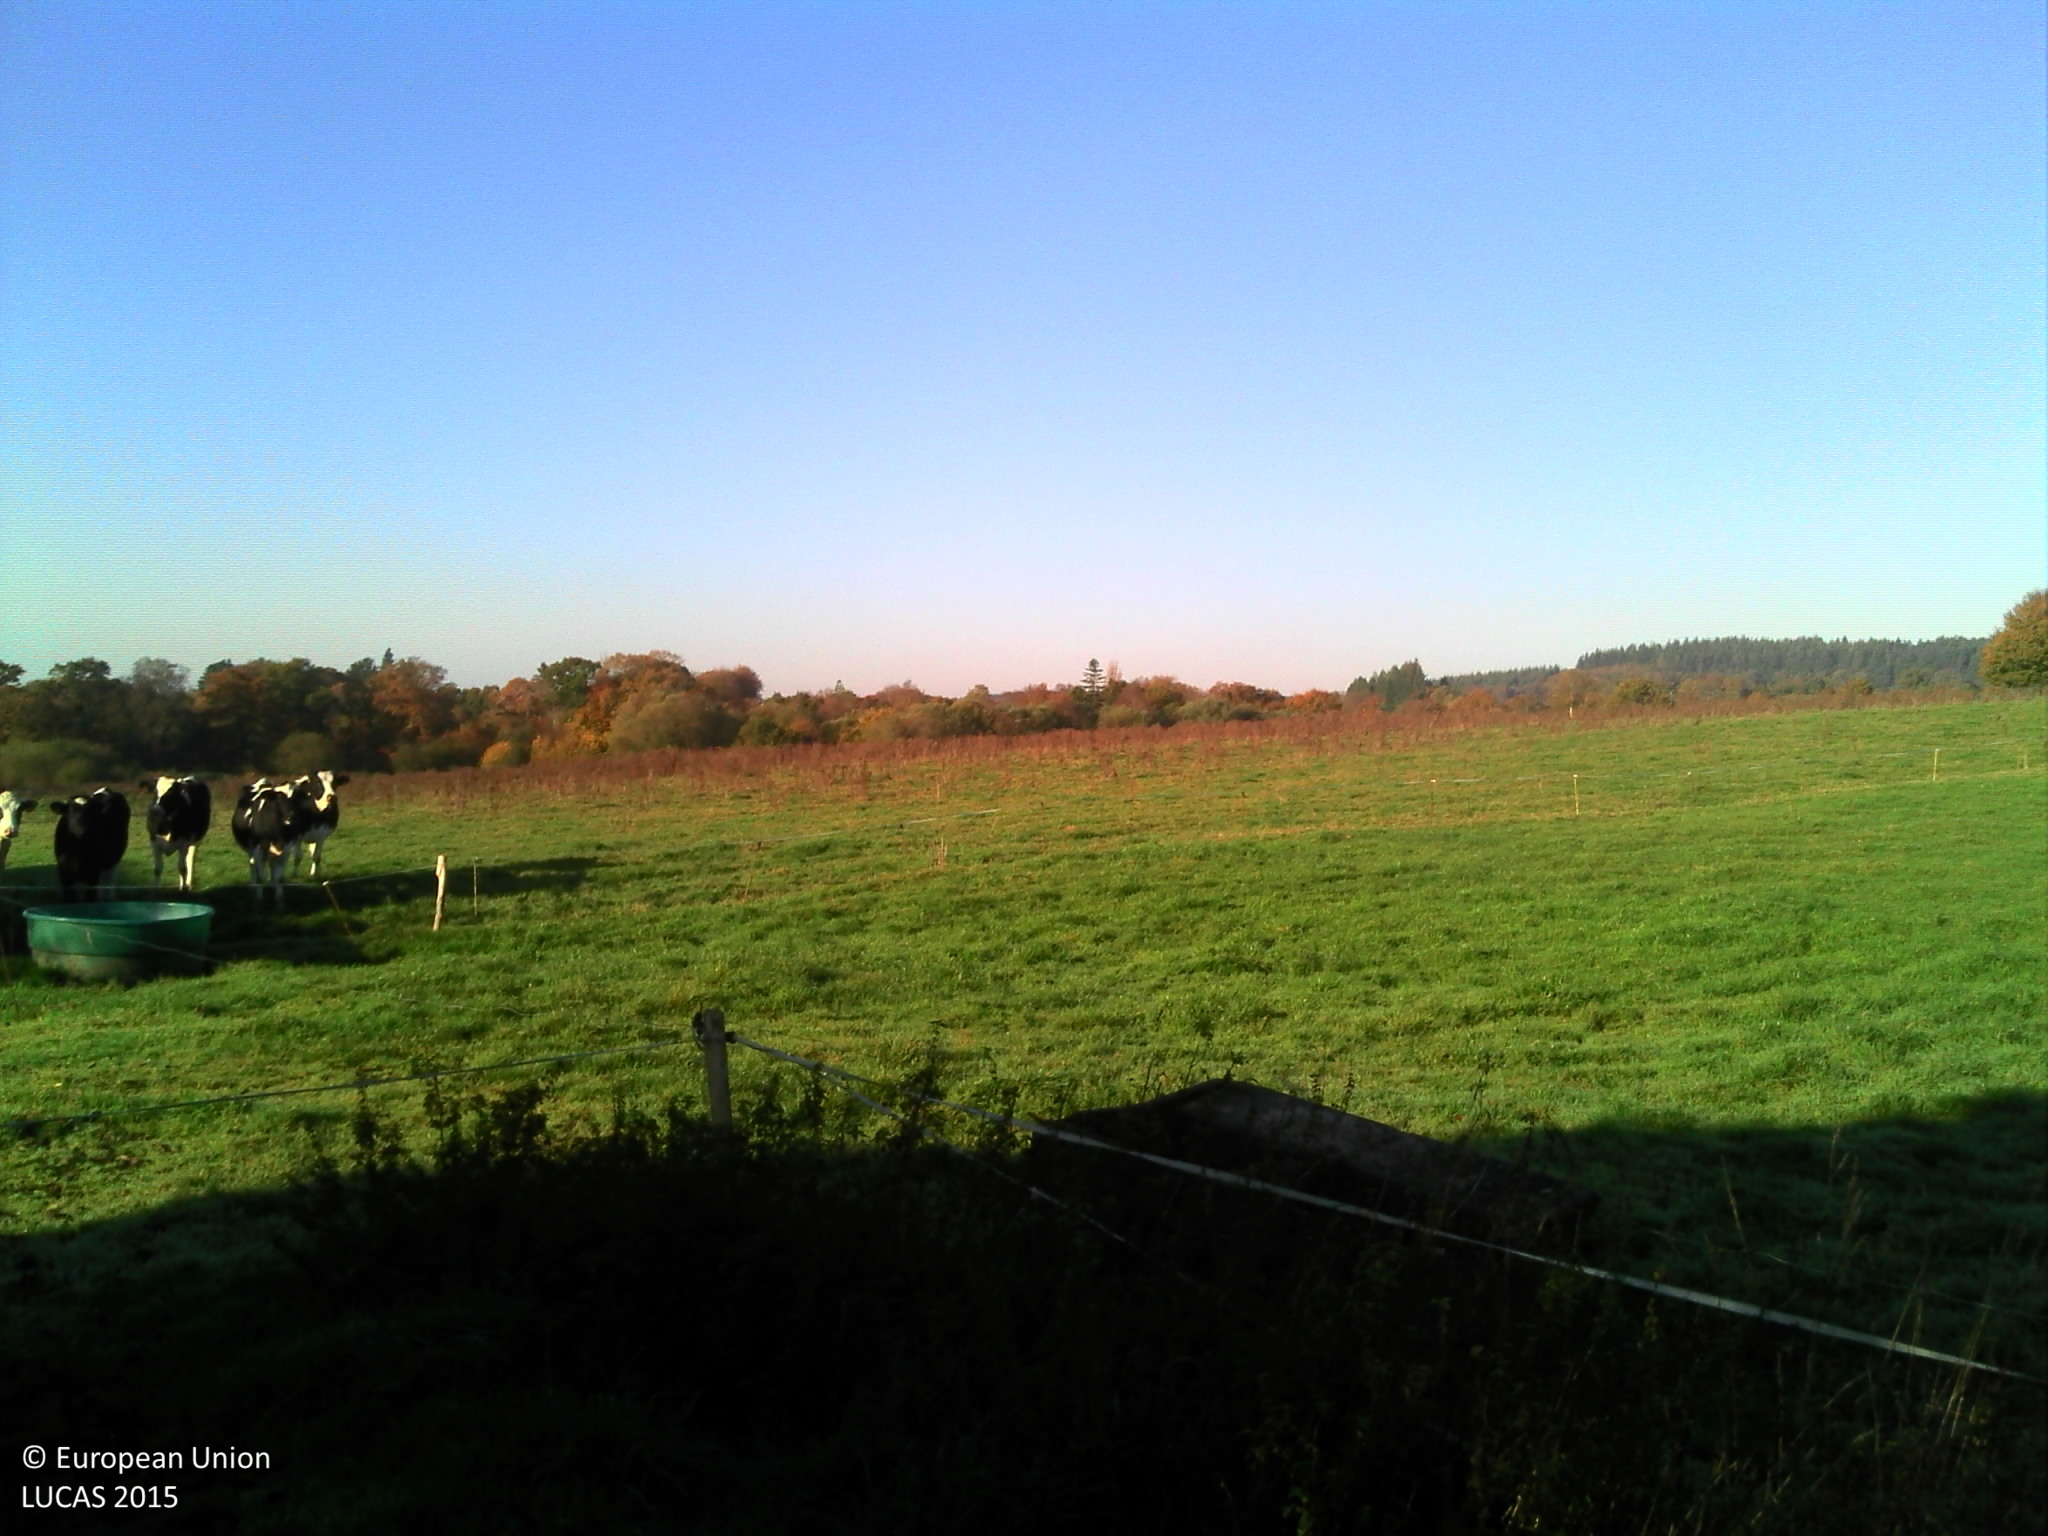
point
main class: Grassland
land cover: Grassland without tree/shrub cover
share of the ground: > 75 %
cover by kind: herbaceous plants 100 %
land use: Agriculture (excluding fallow land and kitchen gardens)
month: November
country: FR
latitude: 48.1027
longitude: -3.3286
